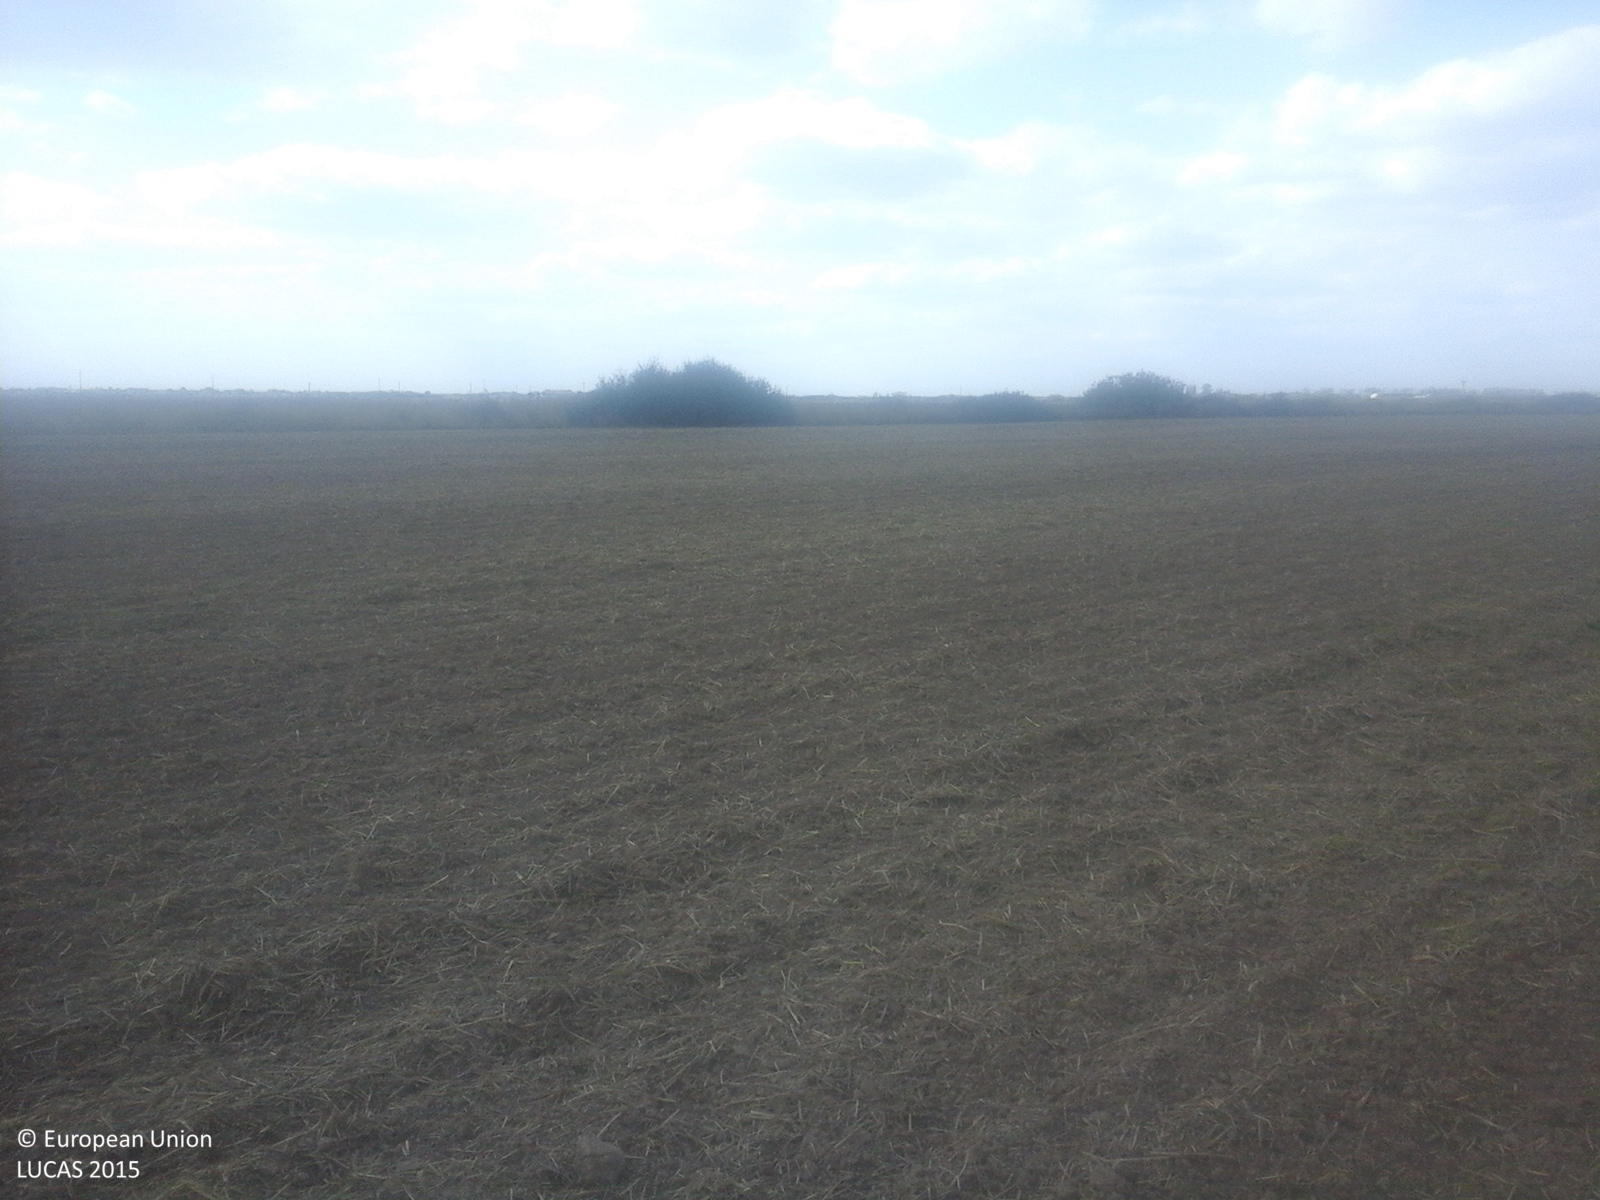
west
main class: Cropland
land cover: Common wheat
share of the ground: < 10 %
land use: Agriculture (excluding fallow land and kitchen gardens)
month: September
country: RO
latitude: 47.6885
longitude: 22.6775
